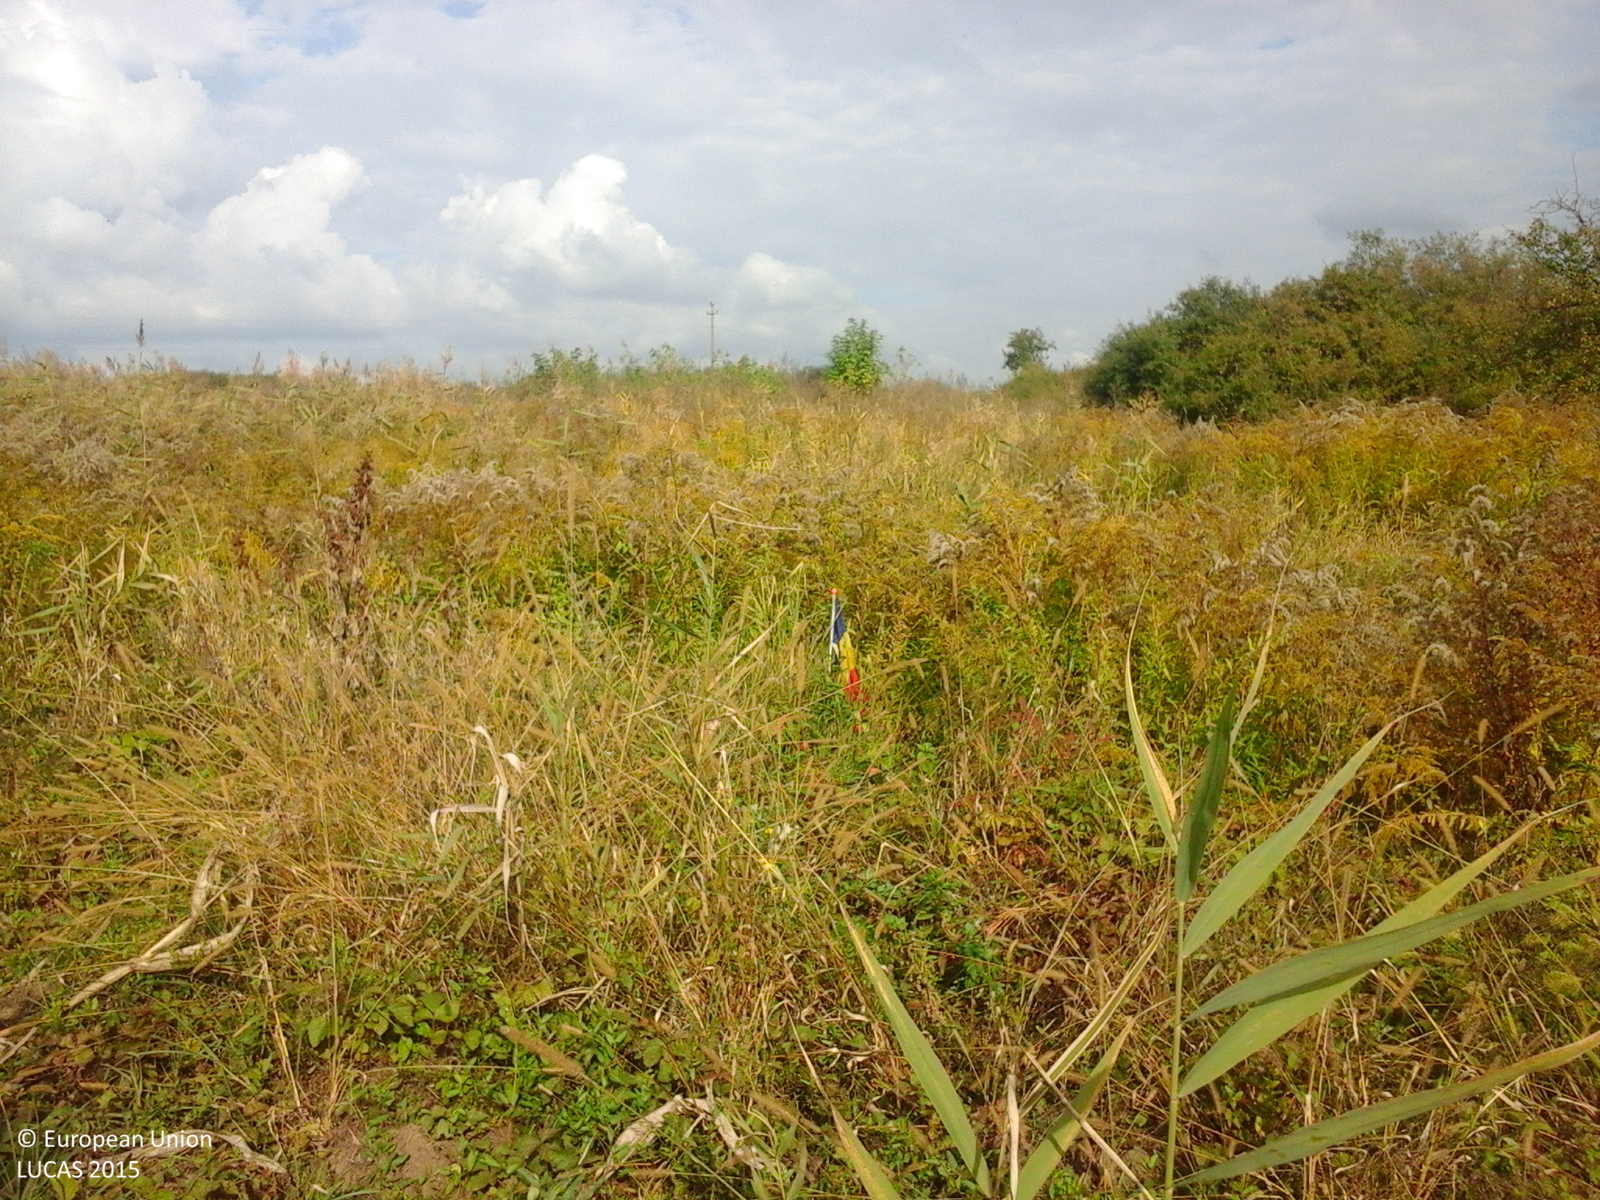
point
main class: Grassland
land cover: Spontaneously vegetated surfaces
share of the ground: > 75 %
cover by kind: herbaceous plants 100 %
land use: Fallow land
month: October
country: RO
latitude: 46.2105
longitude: 24.2732
